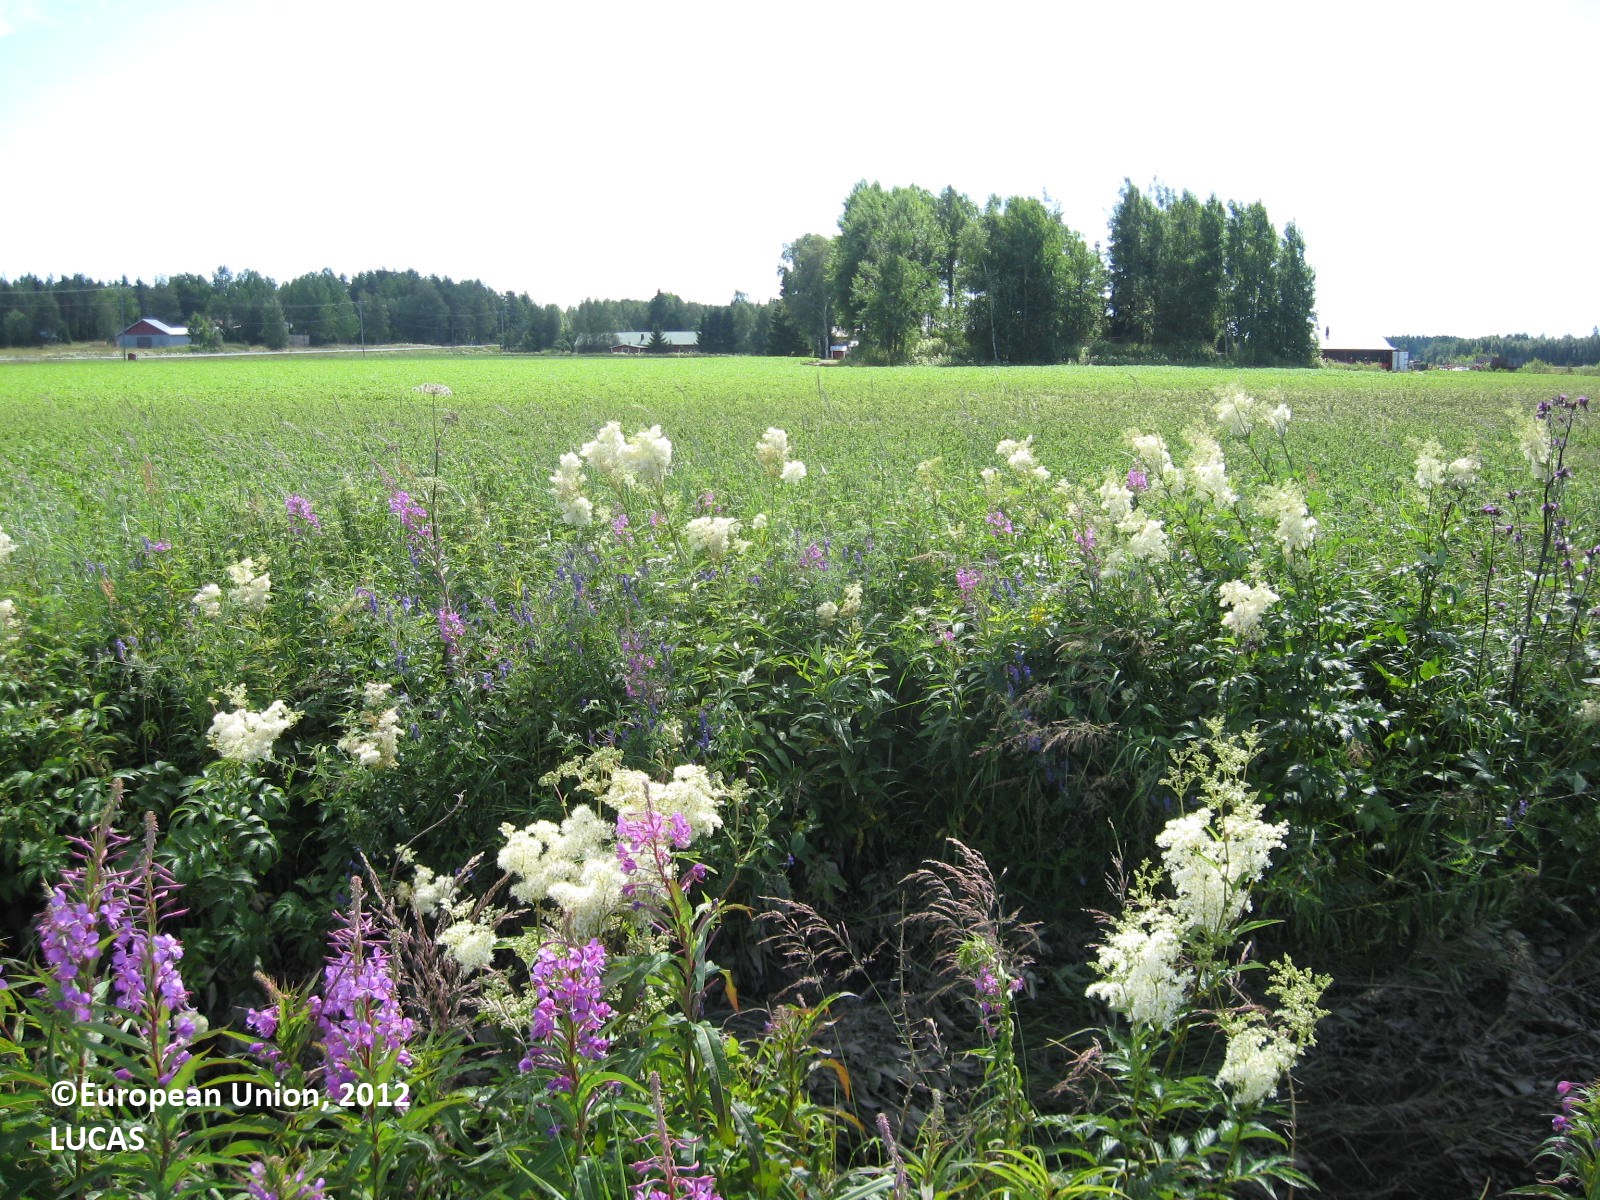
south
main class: Cropland
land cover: Oats
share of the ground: > 75 %
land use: Agriculture (excluding fallow land and kitchen gardens)
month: July
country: FI
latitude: 62.1135
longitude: 21.5264
